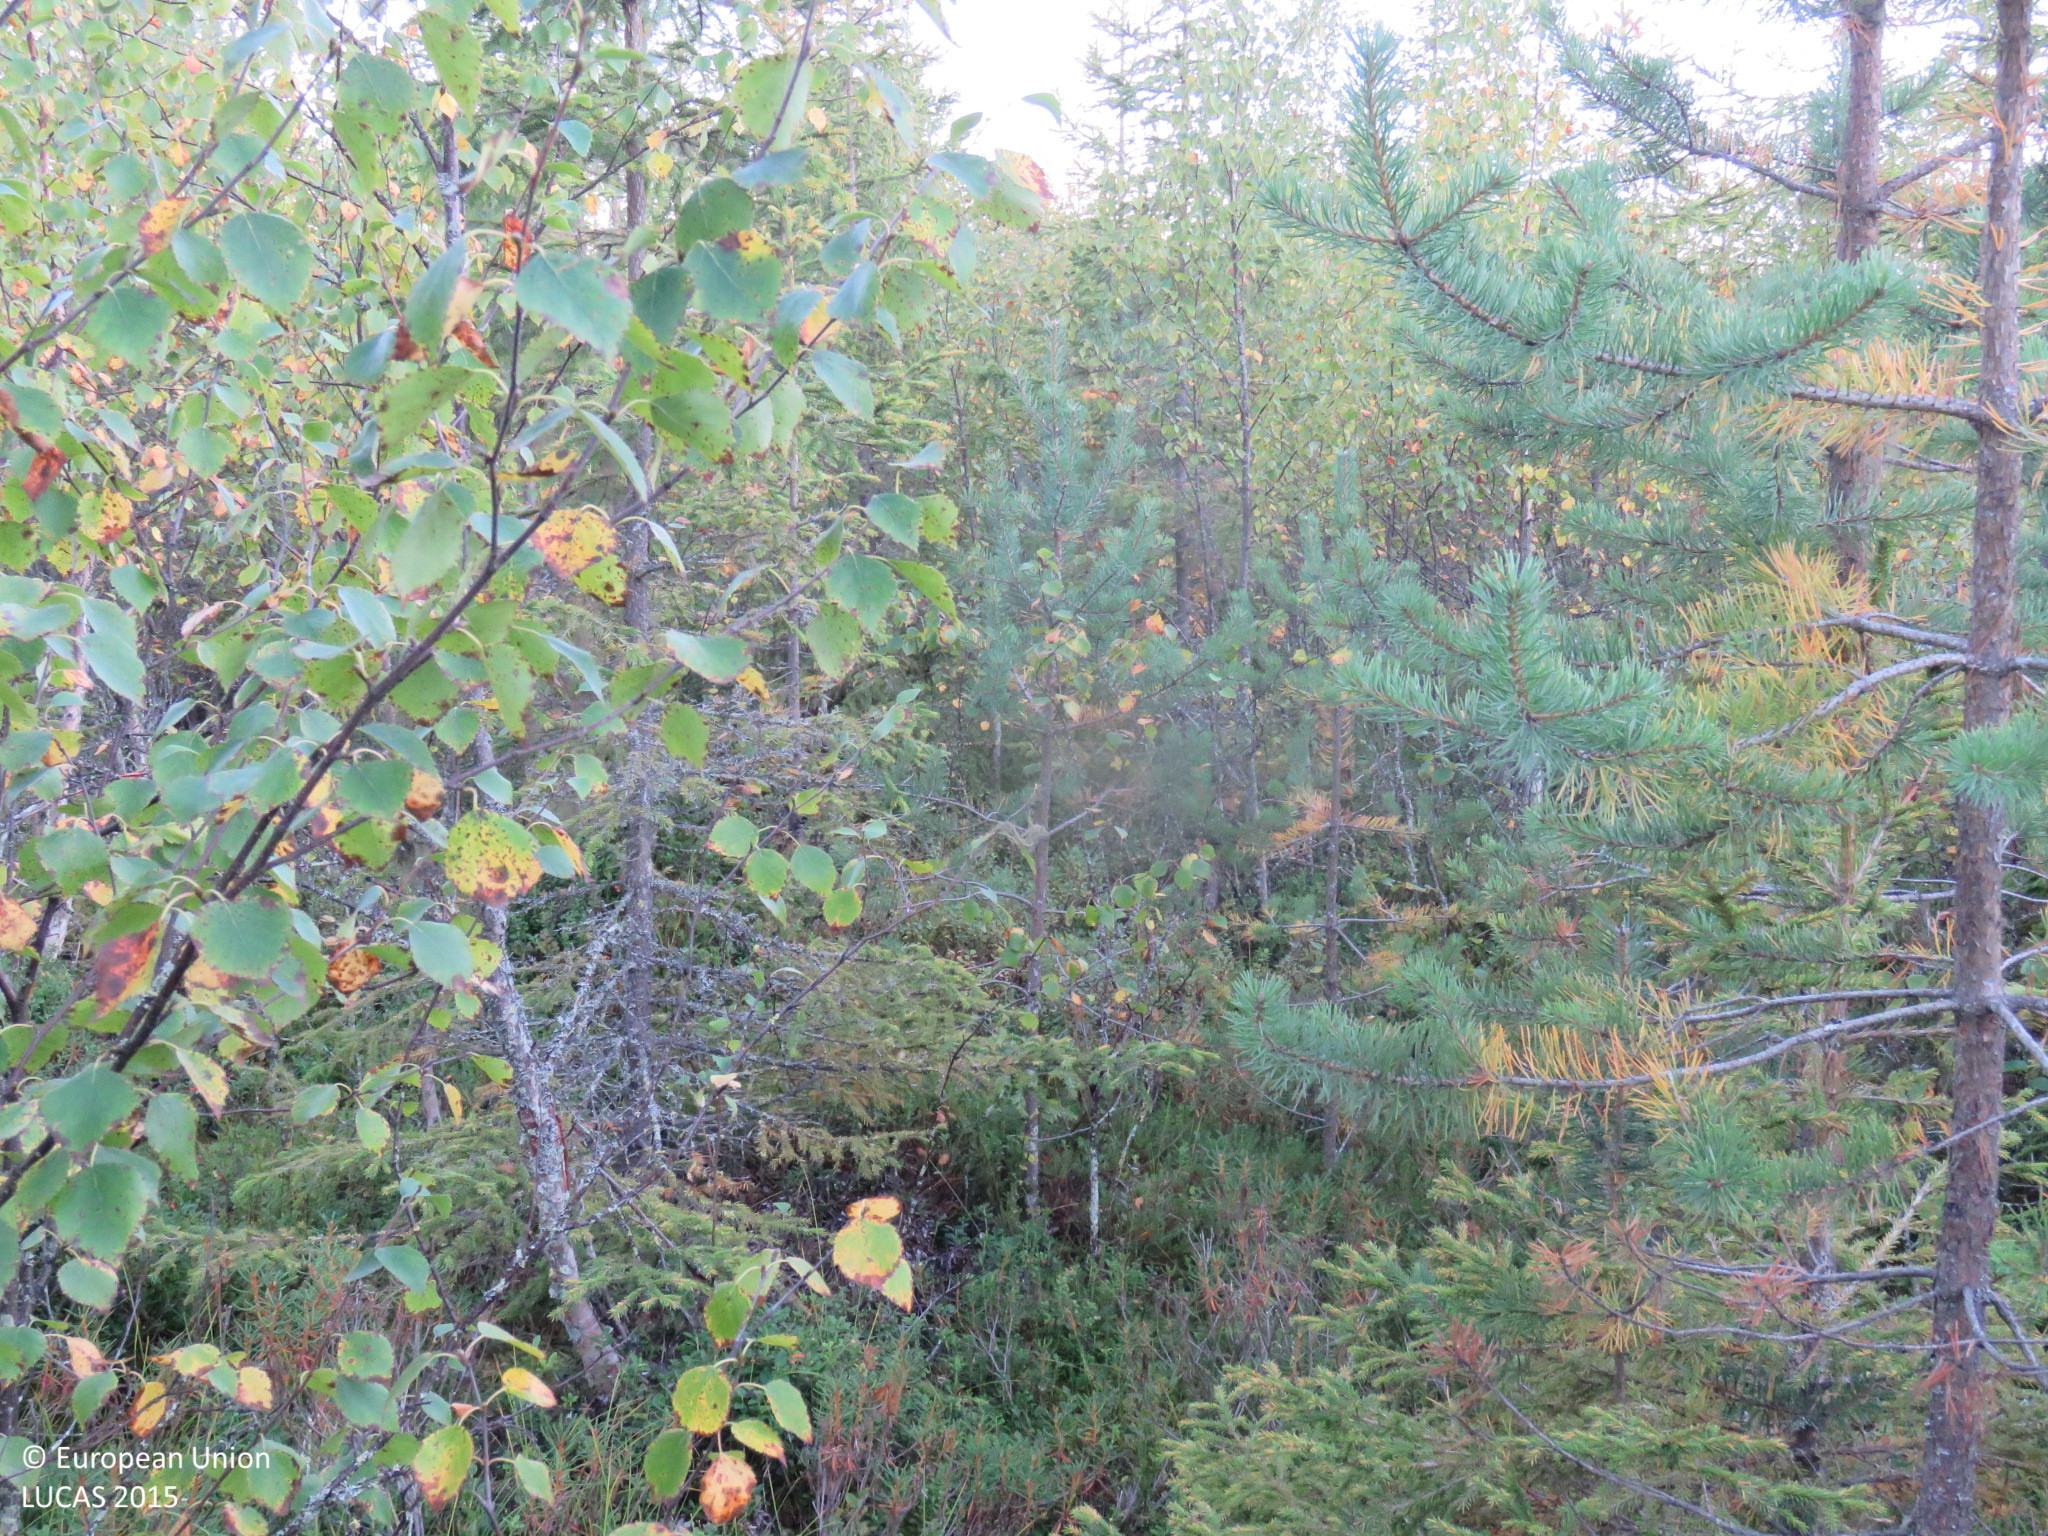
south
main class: Woodland
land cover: Other mixed woodland
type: boreal forest
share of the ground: > 75 %
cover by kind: coniferous forest trees 60 %, broadleaved forest trees 30 %, shrubs 10 %
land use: Forestry
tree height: > 5 m
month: August
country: FI
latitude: 65.3352
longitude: 26.4014
